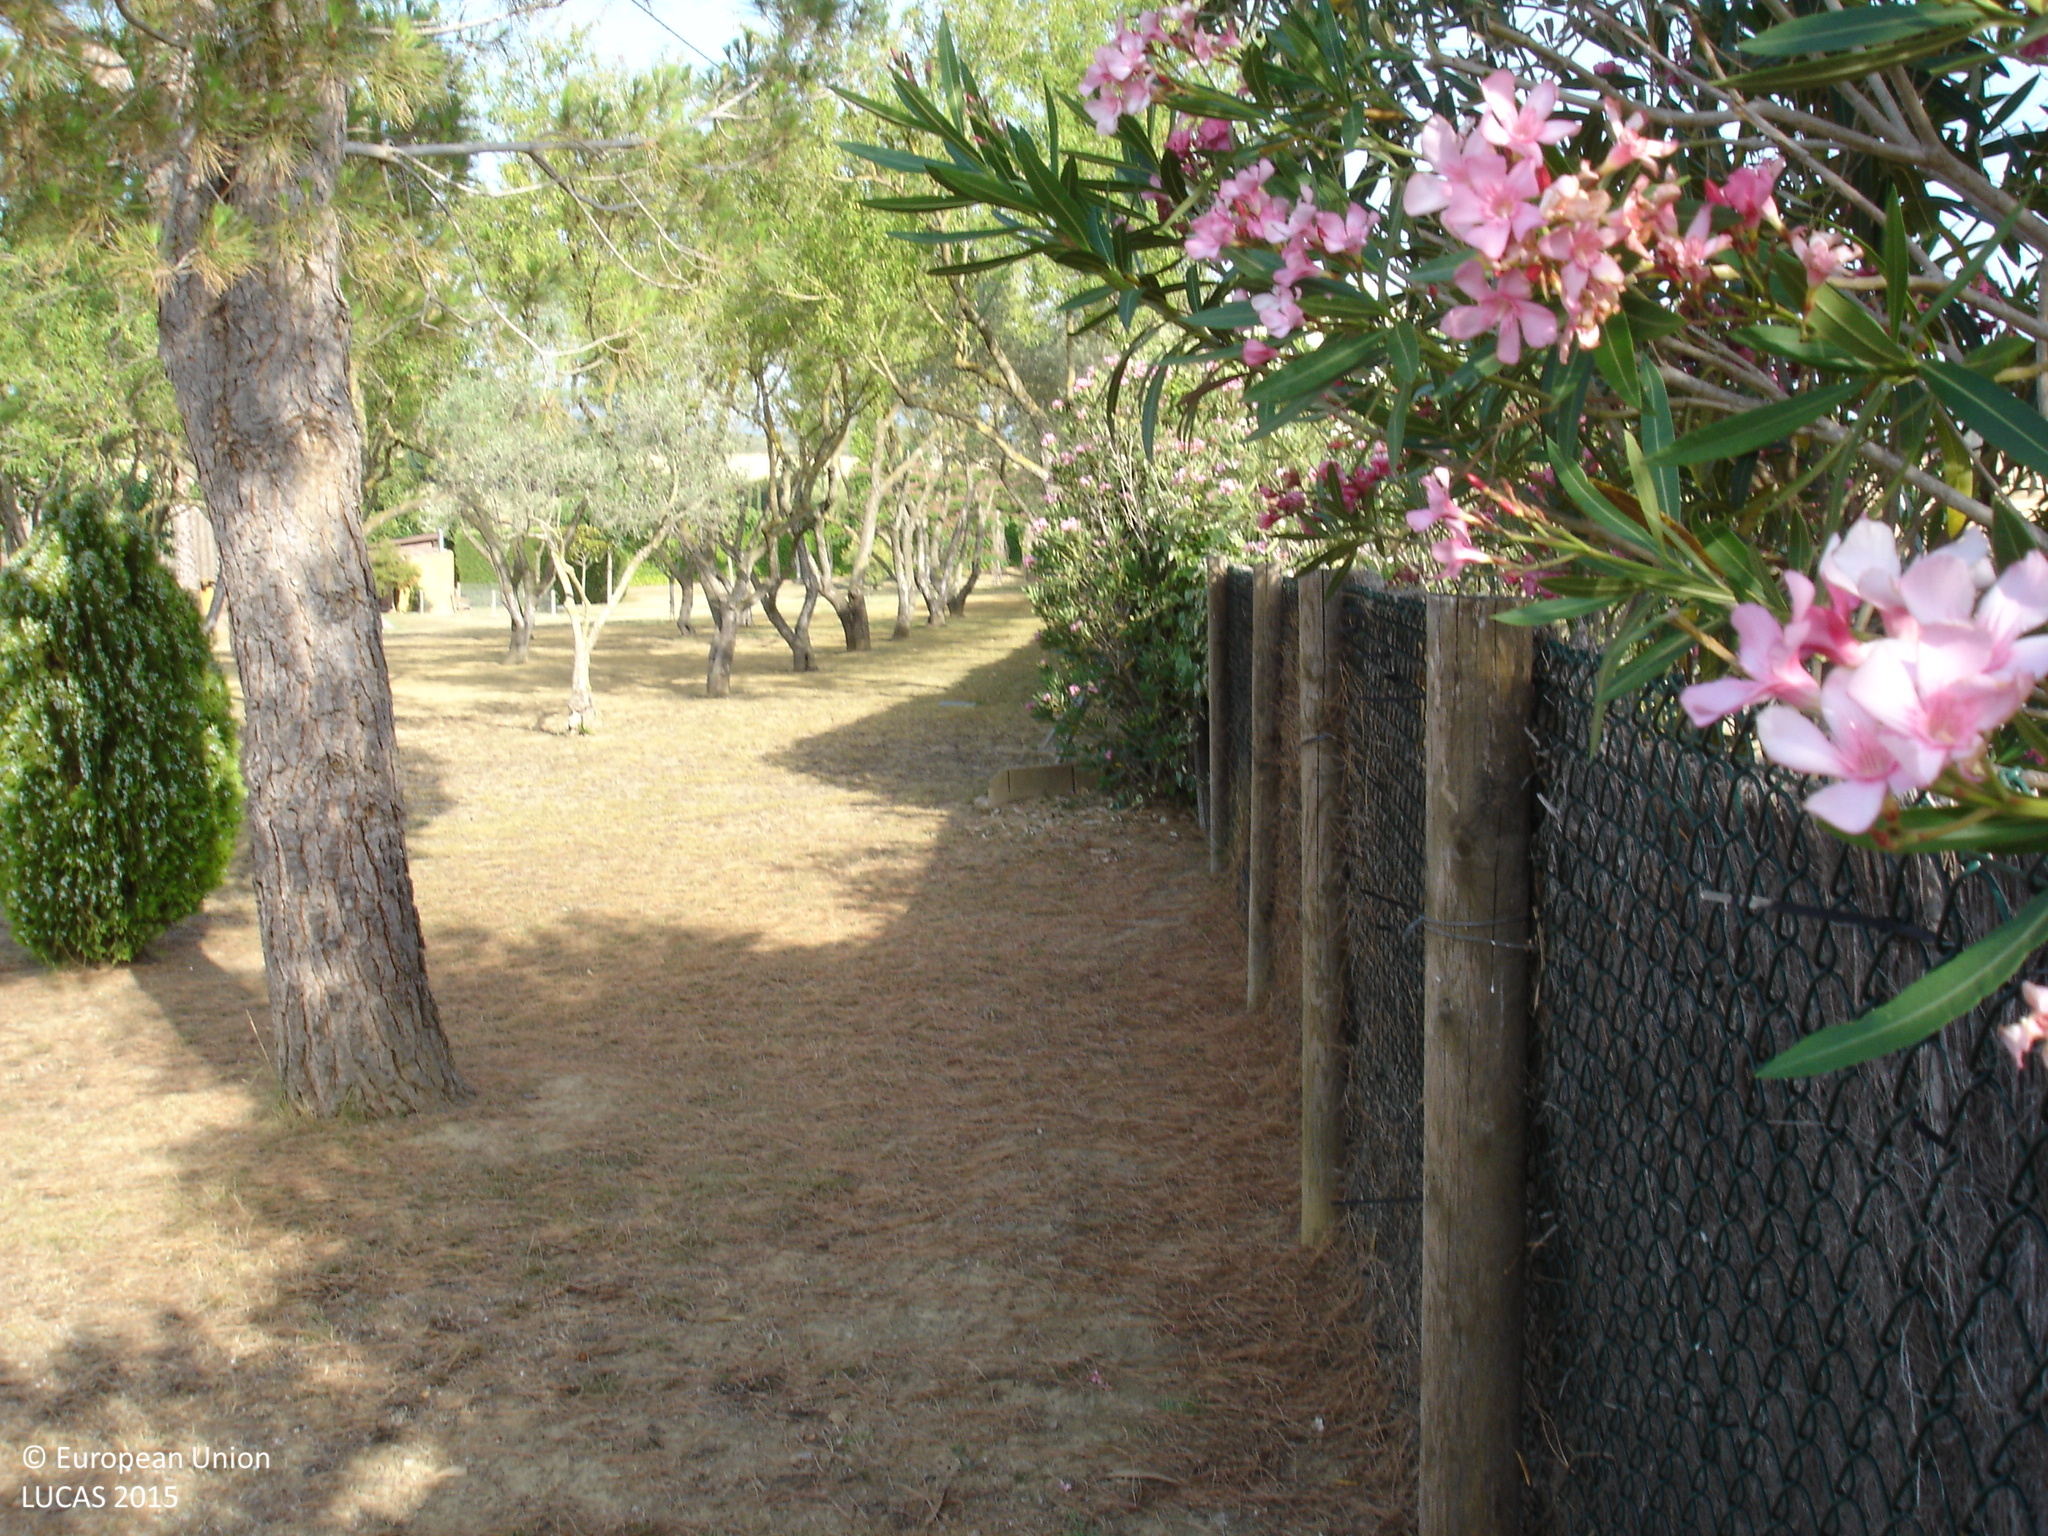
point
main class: Cropland
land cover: Olive groves
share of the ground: 25 - 50 %
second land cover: Other bare soil
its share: > 75 %
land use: Agriculture (excluding fallow land and kitchen gardens)
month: July
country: ES
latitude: 41.9590
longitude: 3.0061
